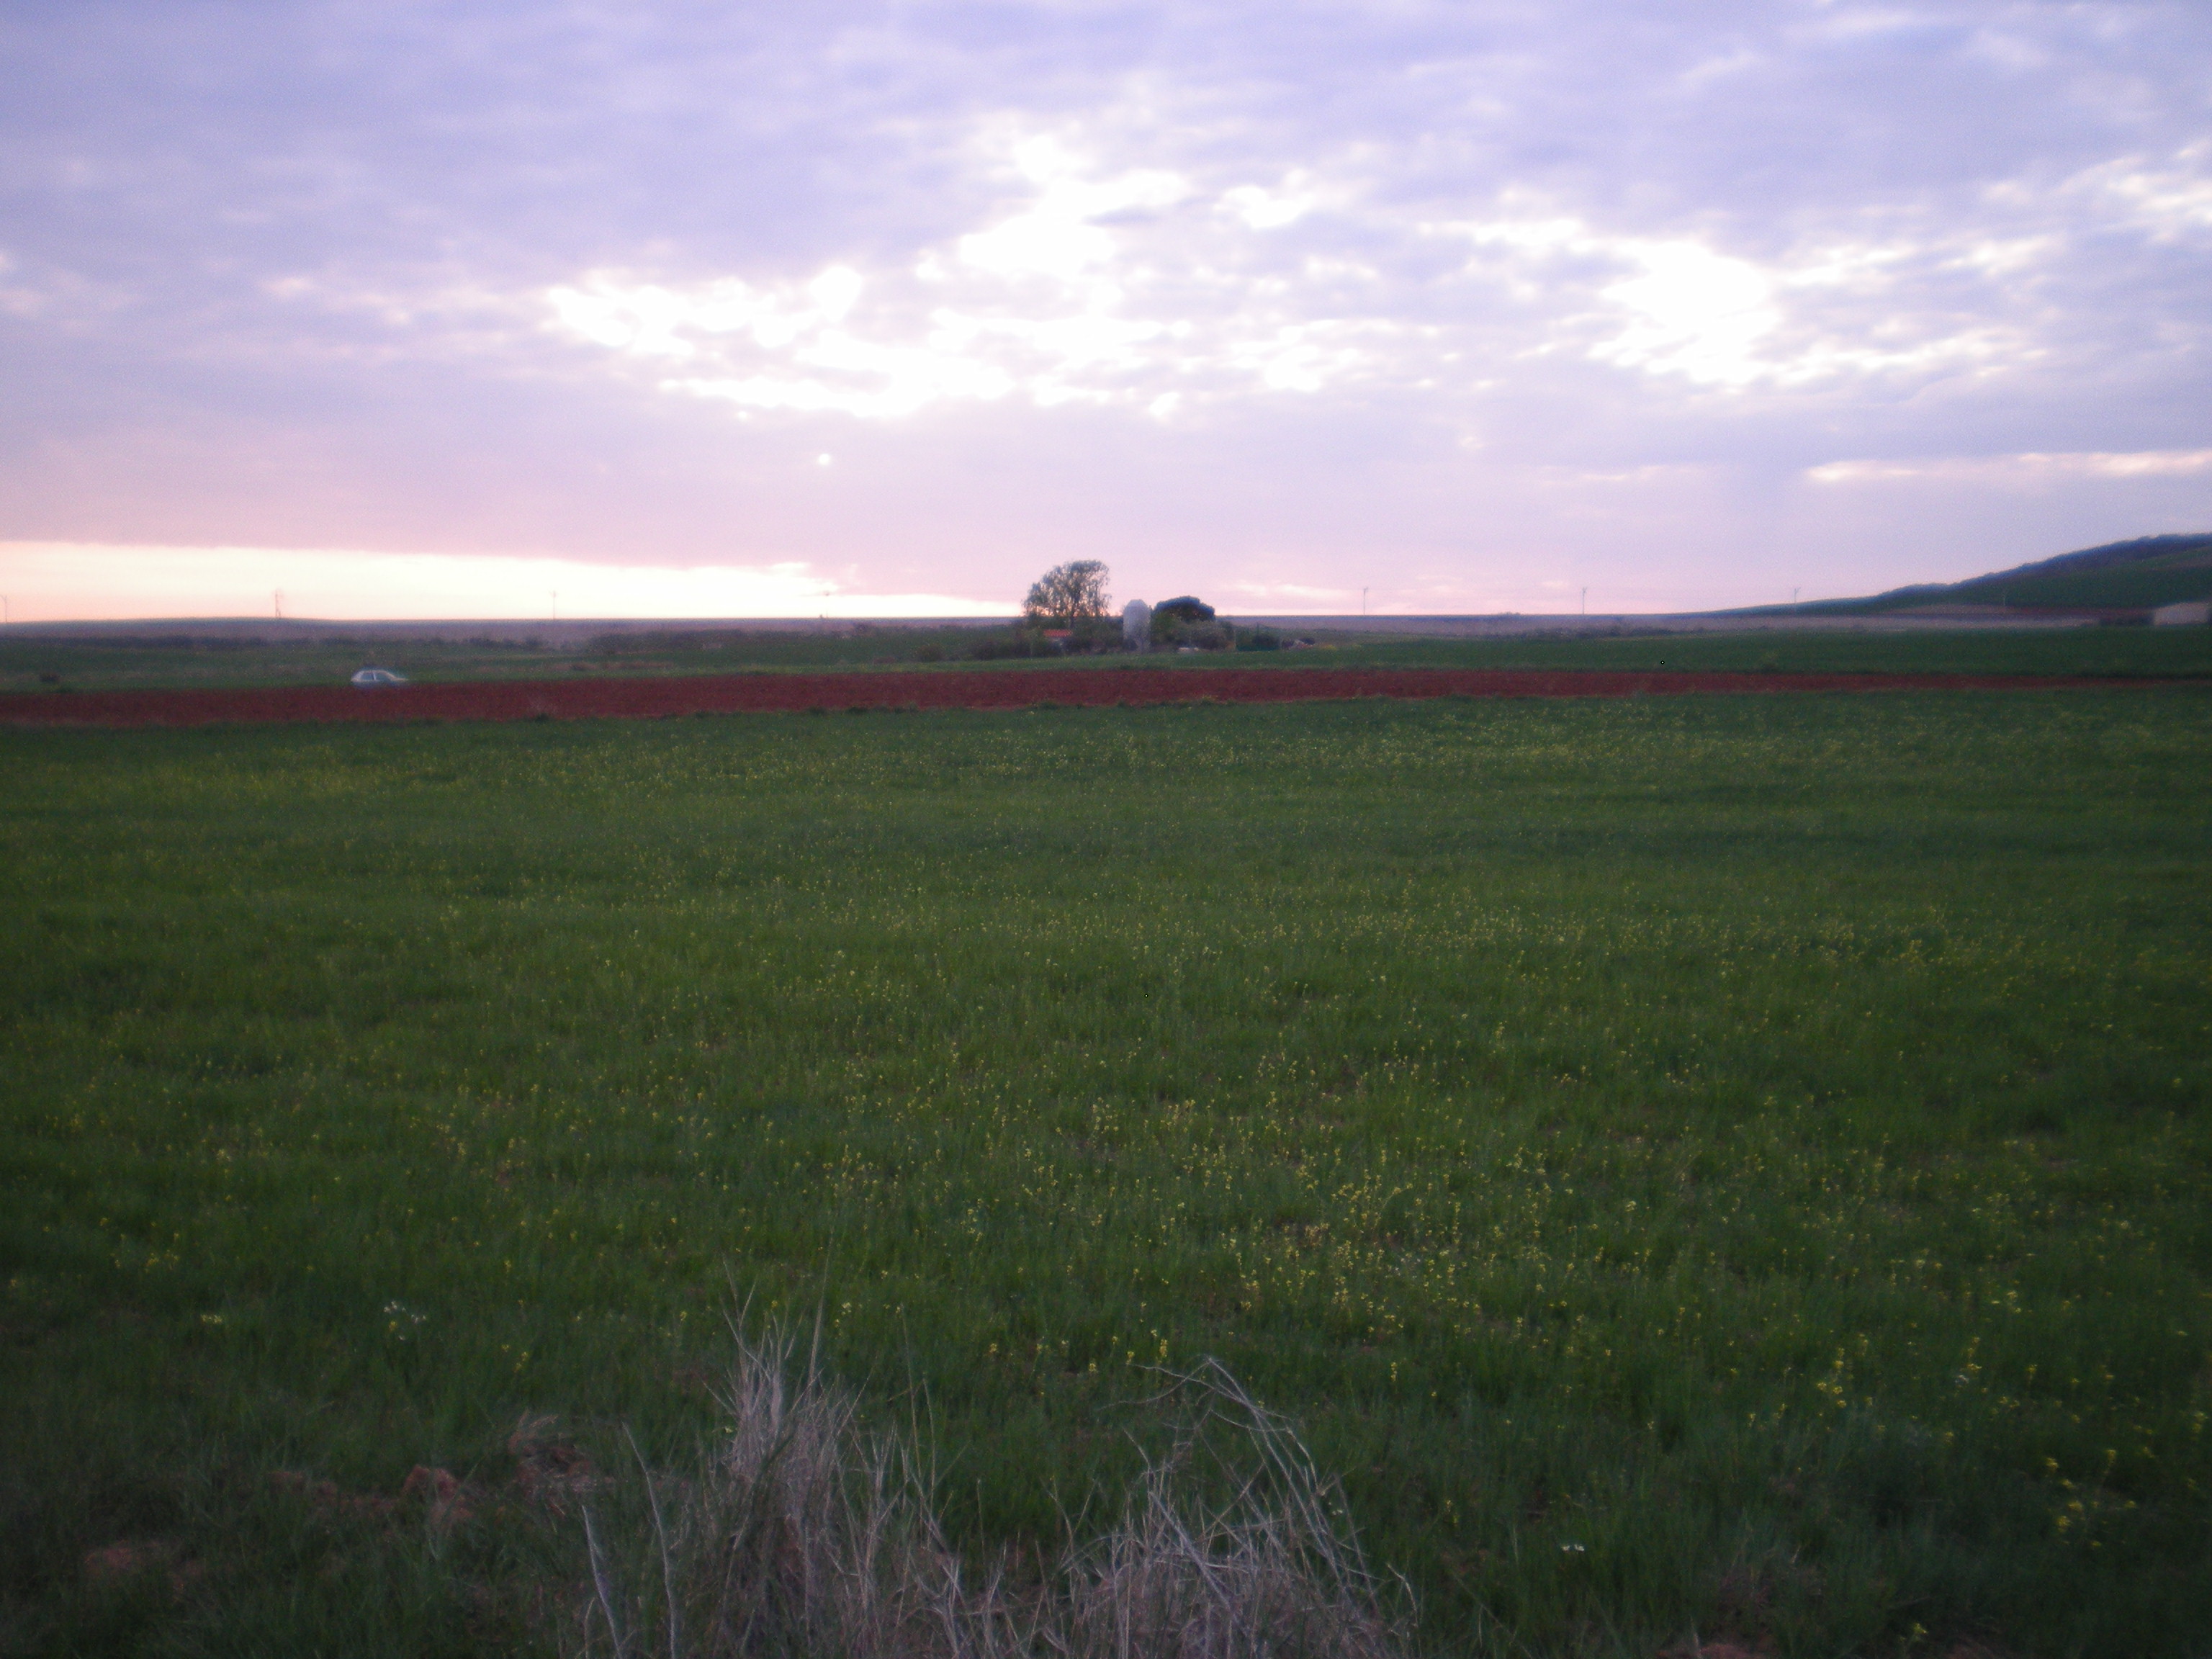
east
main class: Cropland
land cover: Oats
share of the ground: > 75 %
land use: Agriculture (excluding fallow land and kitchen gardens)
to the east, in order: Grass margins; Ditches and canals; Grass margins; Barley; Grass margins; Other bare soil; Grass margins; Durum wheat; Grass margins; Tracks; Grass margins; Barley; Fences; Managed hedges; Nuts trees; Artificial constructions in urban areas
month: April
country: ES
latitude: 38.6206
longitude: -3.4594
